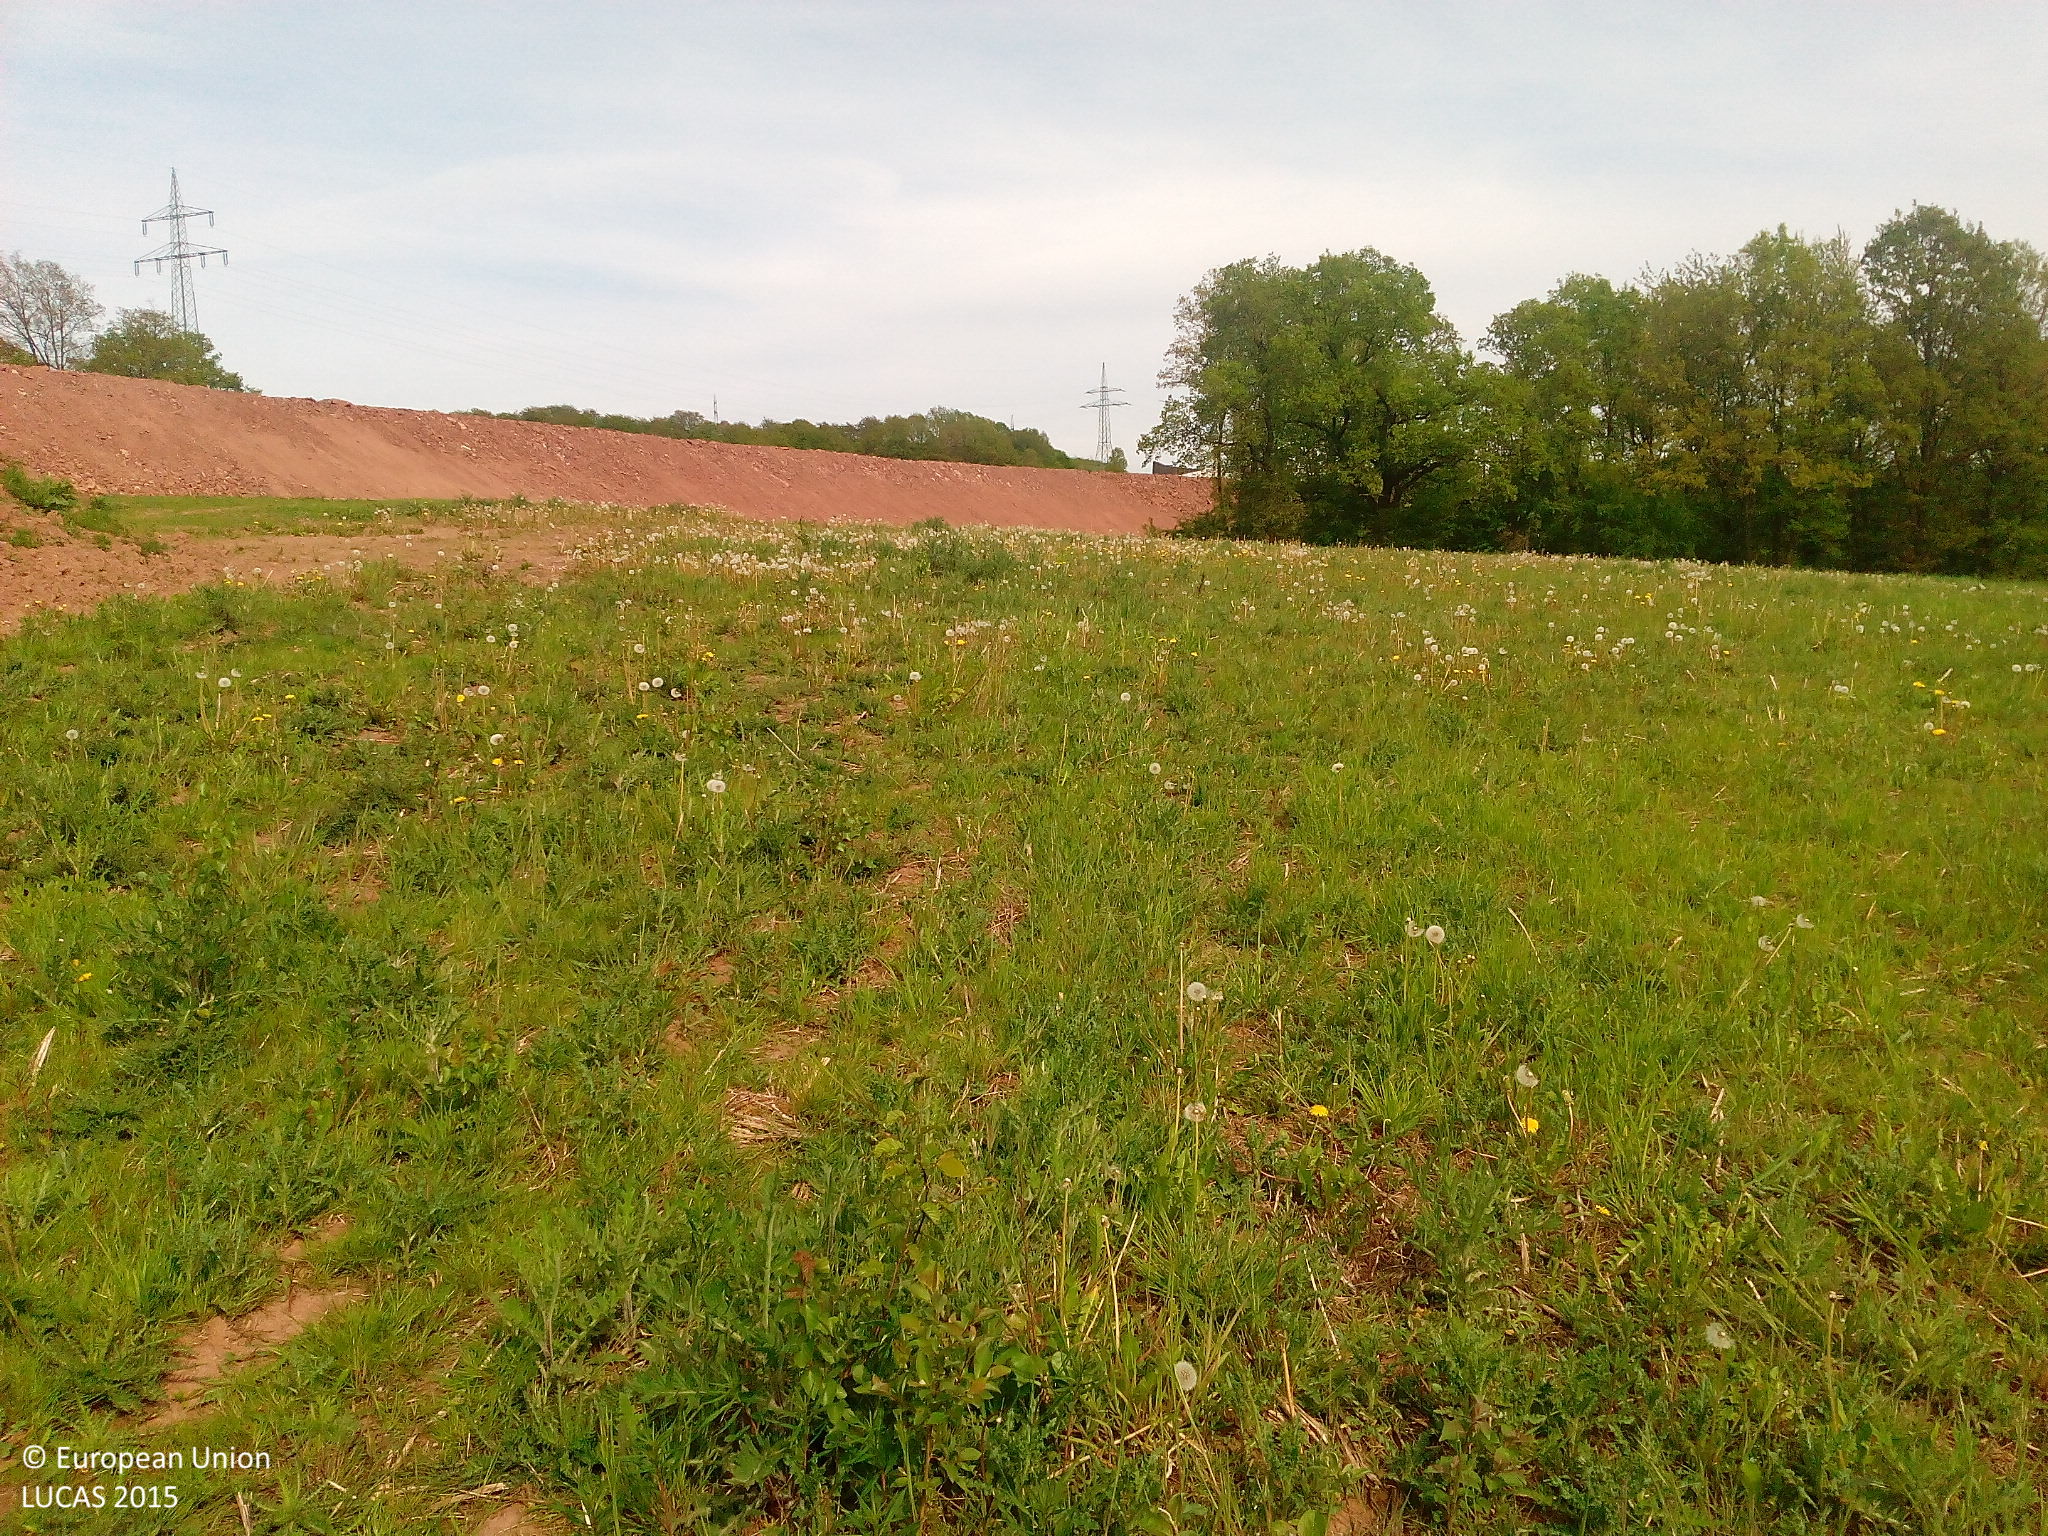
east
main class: Grassland
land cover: Spontaneously vegetated surfaces
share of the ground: > 75 %
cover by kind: herbaceous plants 80 %, unconsolidated bare surface 20 %
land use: Fallow land
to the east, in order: Spontaneously vegetated surfaces; Tracks; Other bare soil; Tracks
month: May
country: DE
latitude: 51.1551
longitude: 9.8714
